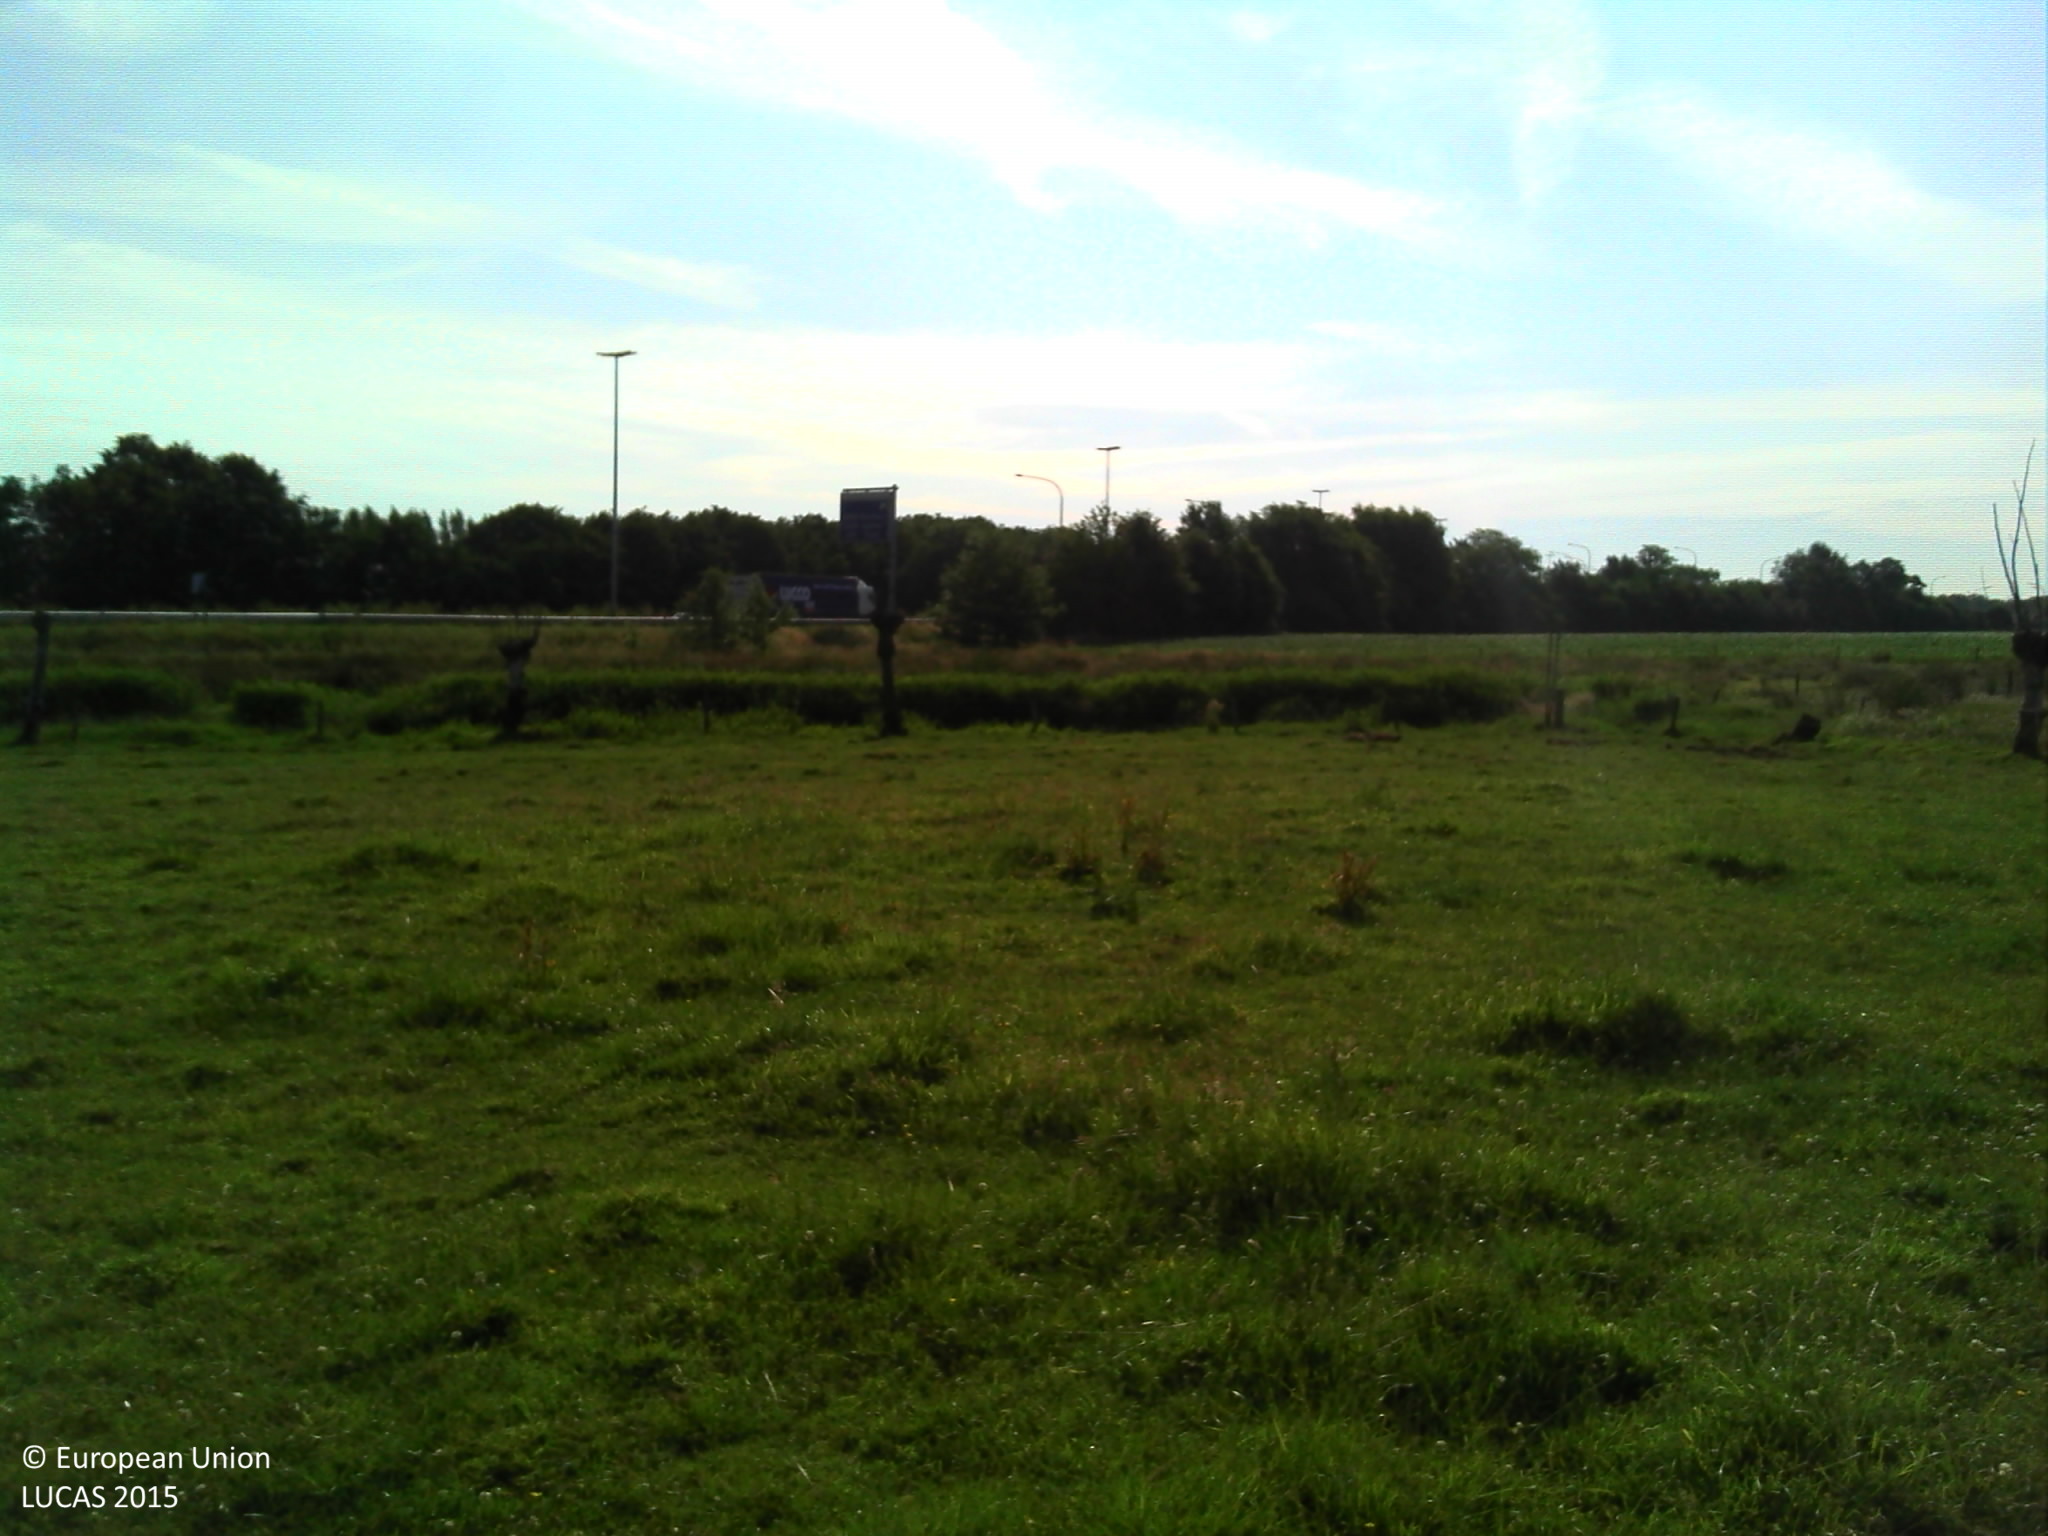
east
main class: Grassland
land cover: Grassland without tree/shrub cover
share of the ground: > 75 %
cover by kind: herbaceous plants 100 %
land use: Agriculture (excluding fallow land and kitchen gardens)
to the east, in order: Grassland without tree/shrub cover; Fences; Lines of trees; Ditches and canals; Fences; Grassland without tree/shrub cover; Fences; Grass margins; Ditches and canals; Grass margins; Grassland without tree/shrub cover; Paved roads, cycling and walking lanes; Broadleaved woodland
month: July
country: BE
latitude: 51.0777
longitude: 3.4403
